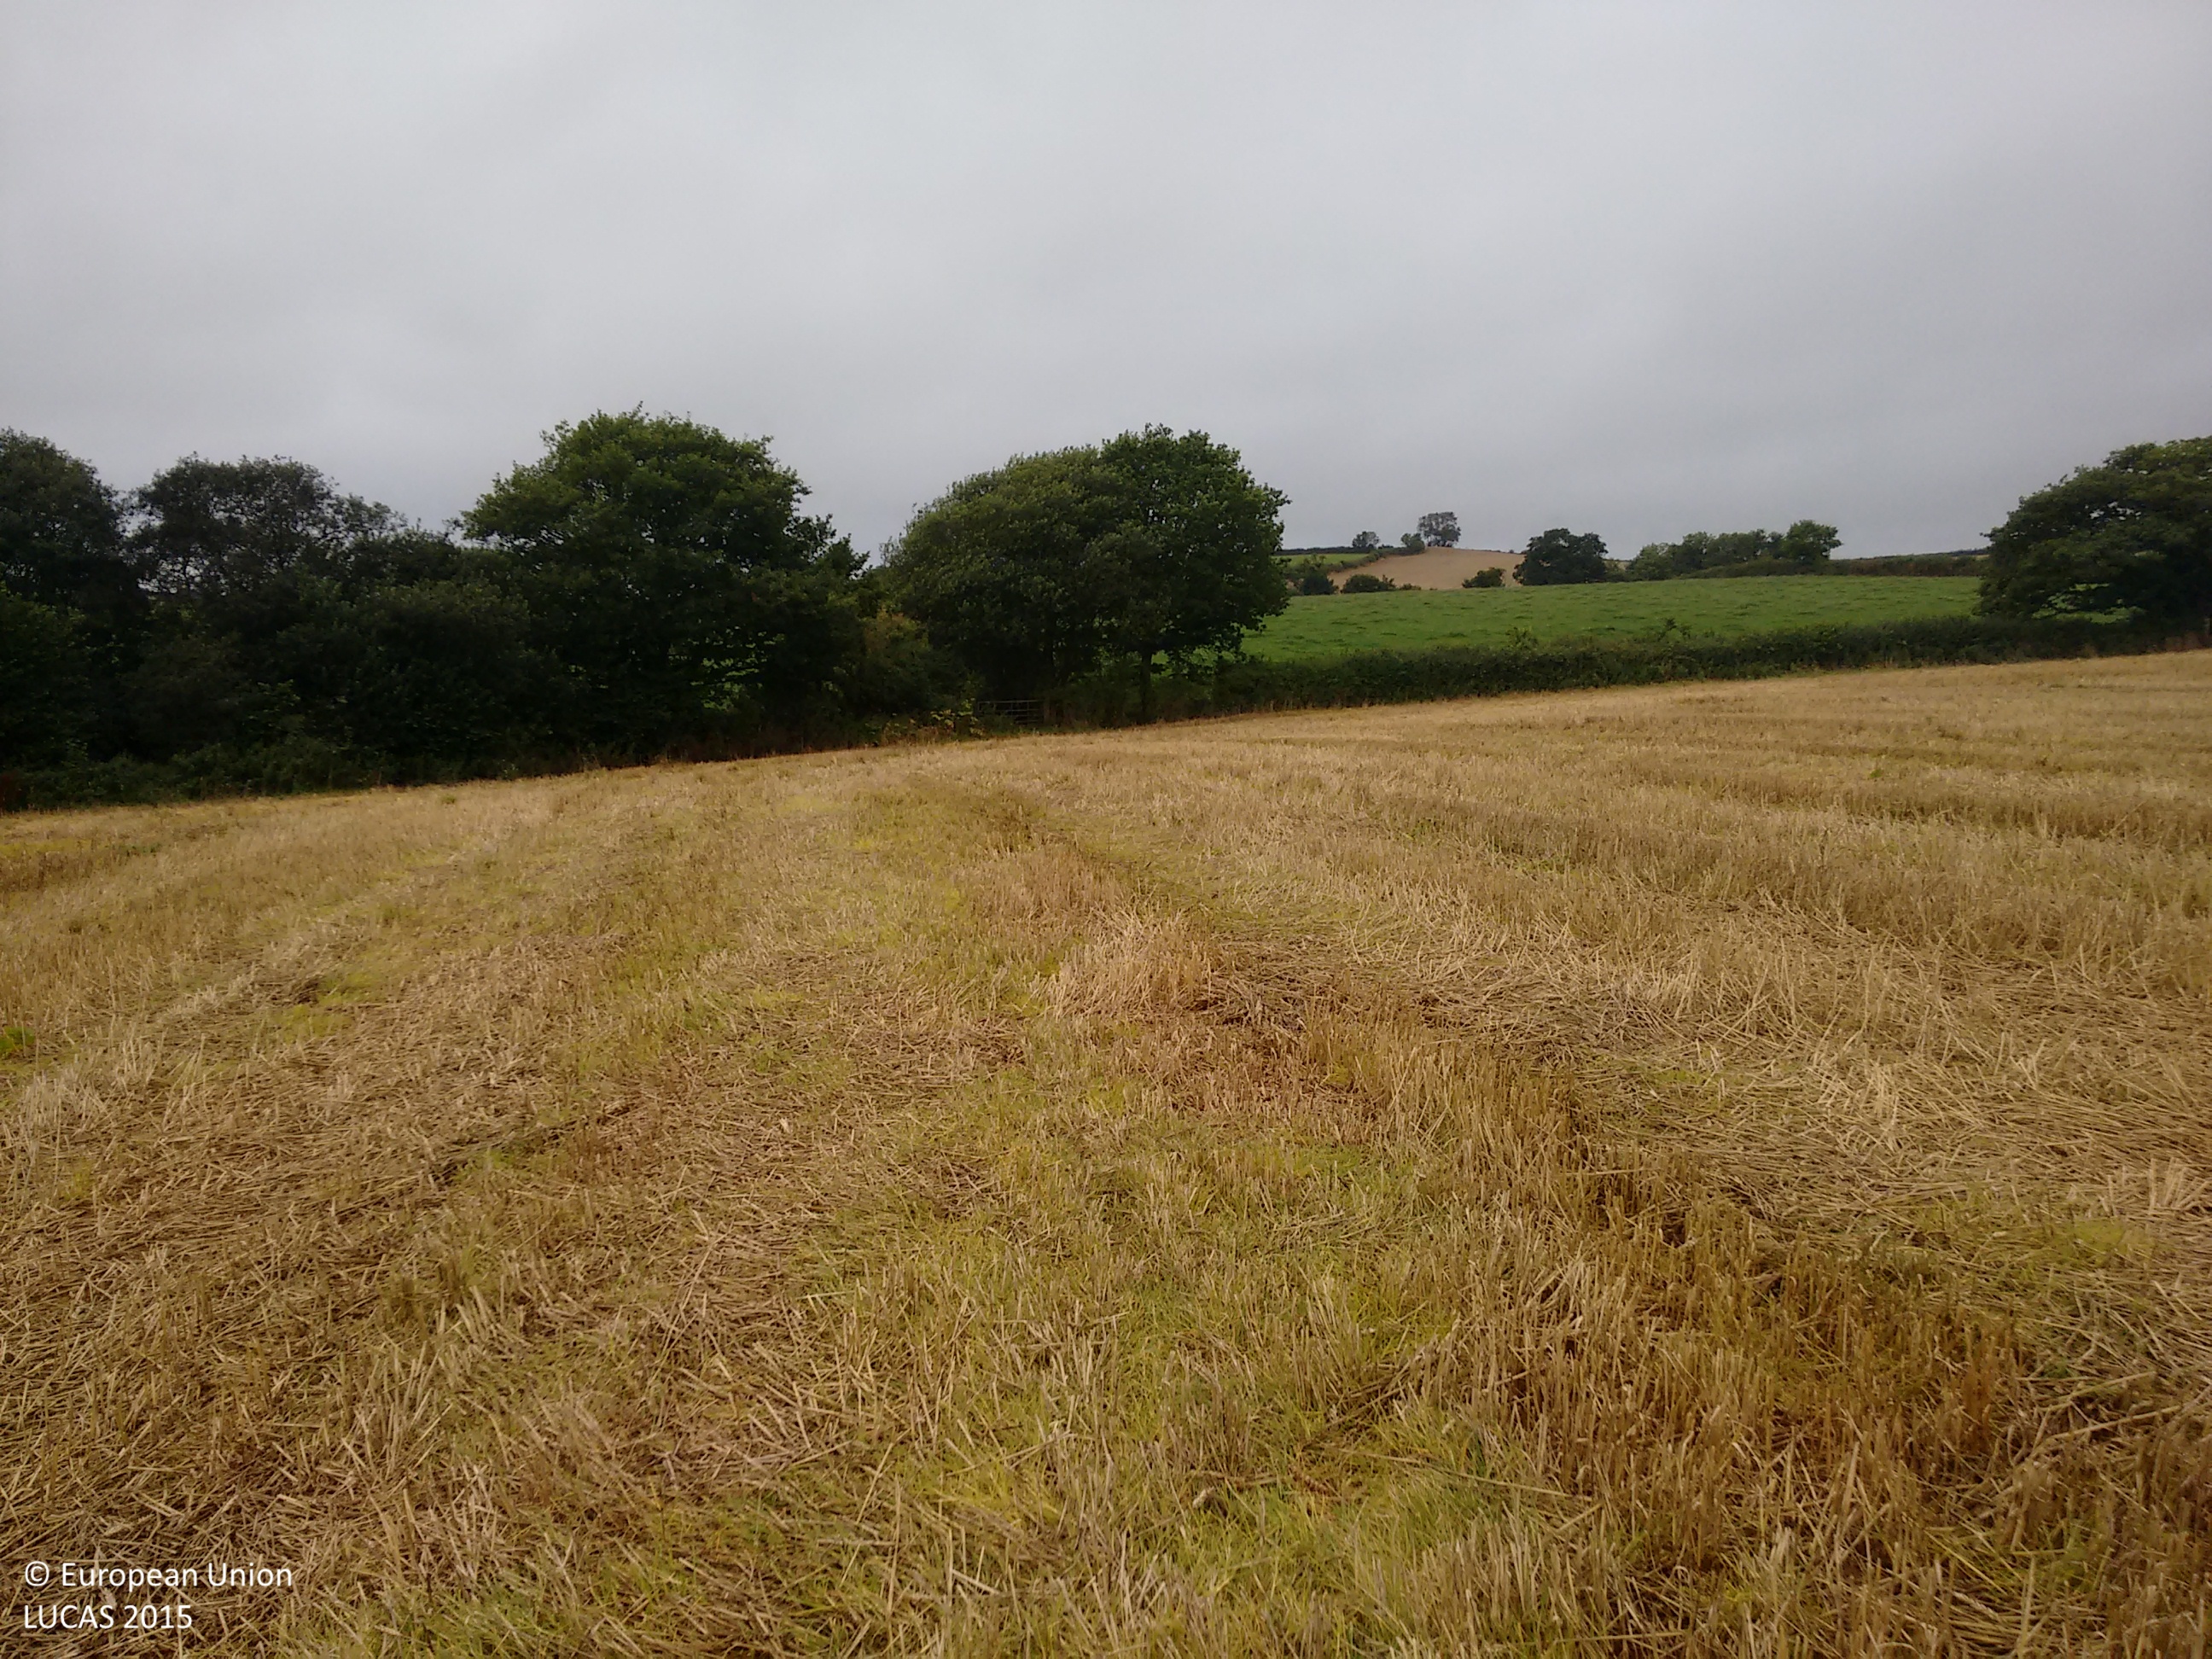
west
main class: Cropland
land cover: Barley
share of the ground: > 75 %
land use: Agriculture (excluding fallow land and kitchen gardens)
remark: Harvested field
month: August
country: GB
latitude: 50.8606
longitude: -3.5969
